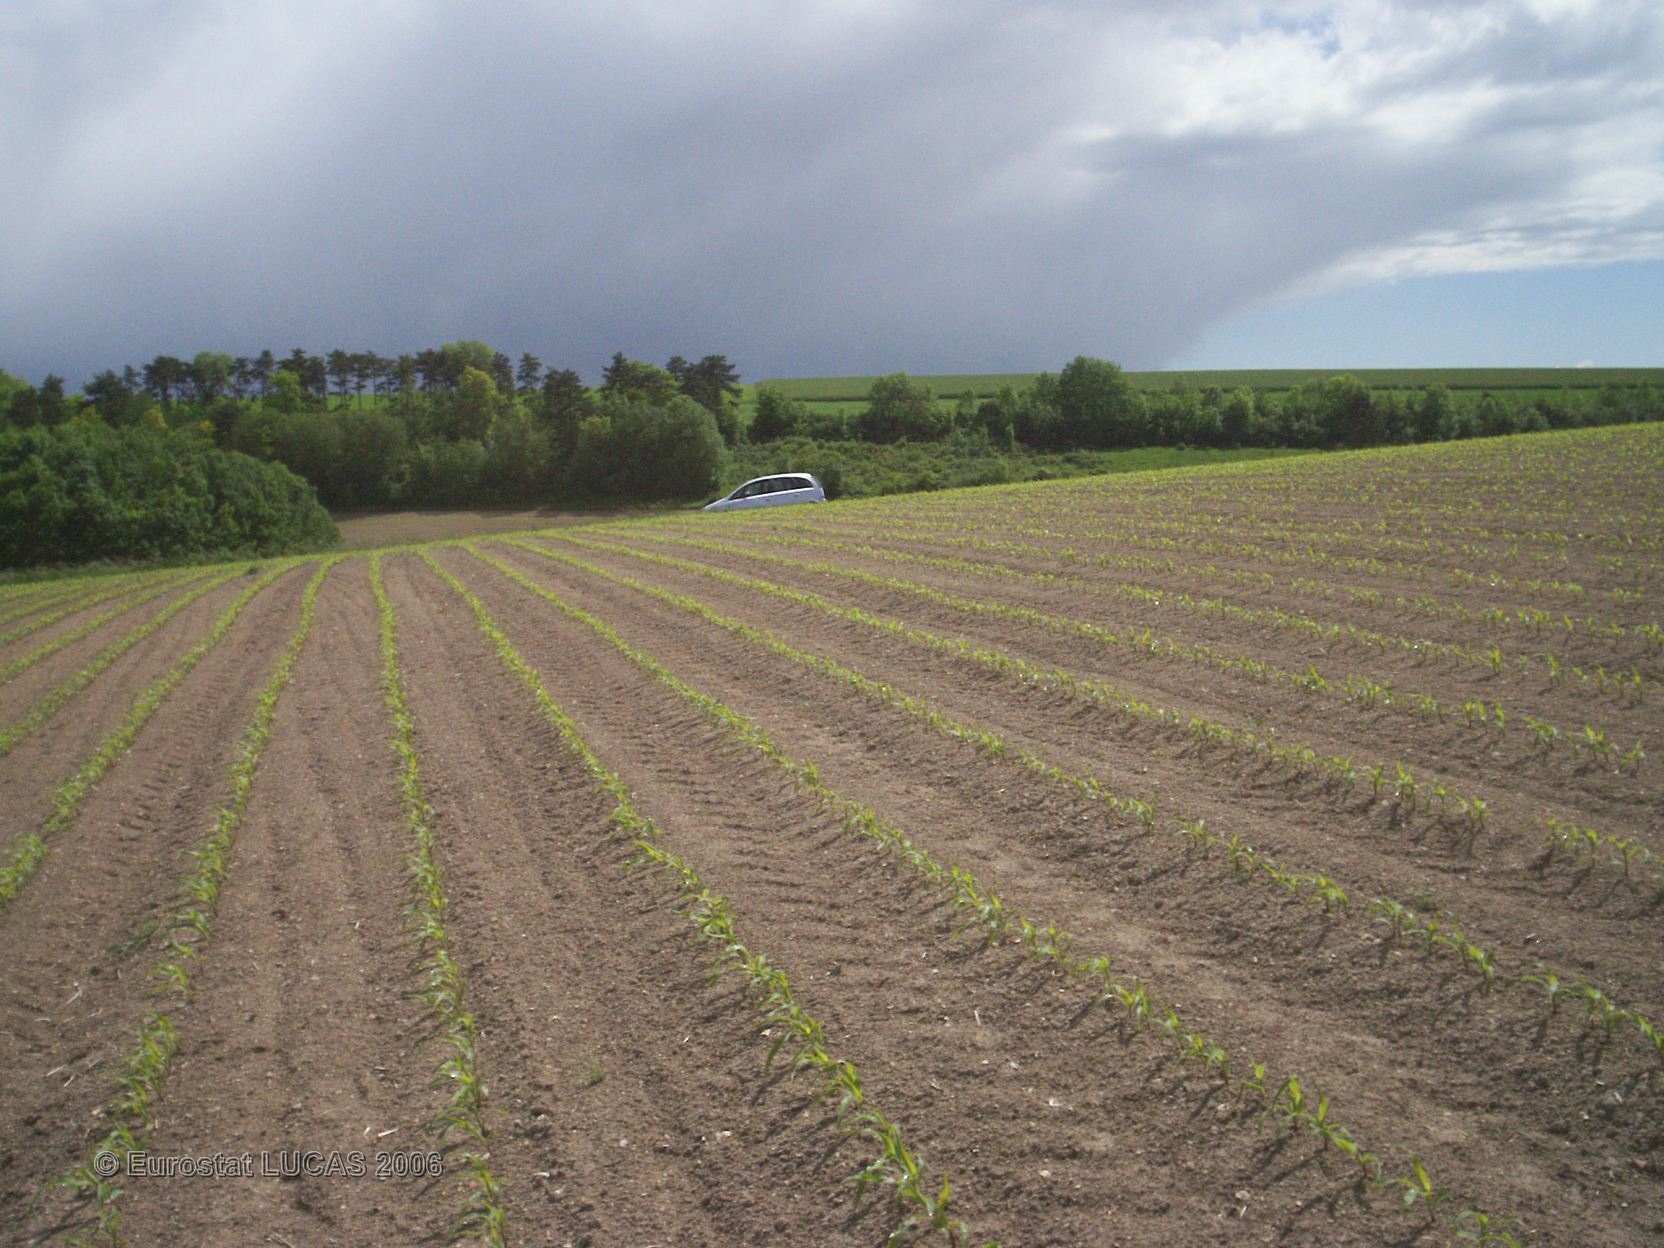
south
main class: Cropland
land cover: Maize
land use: Agriculture (excluding fallow land and kitchen gardens)
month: May
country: FR
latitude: 49.4244
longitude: 4.5784
